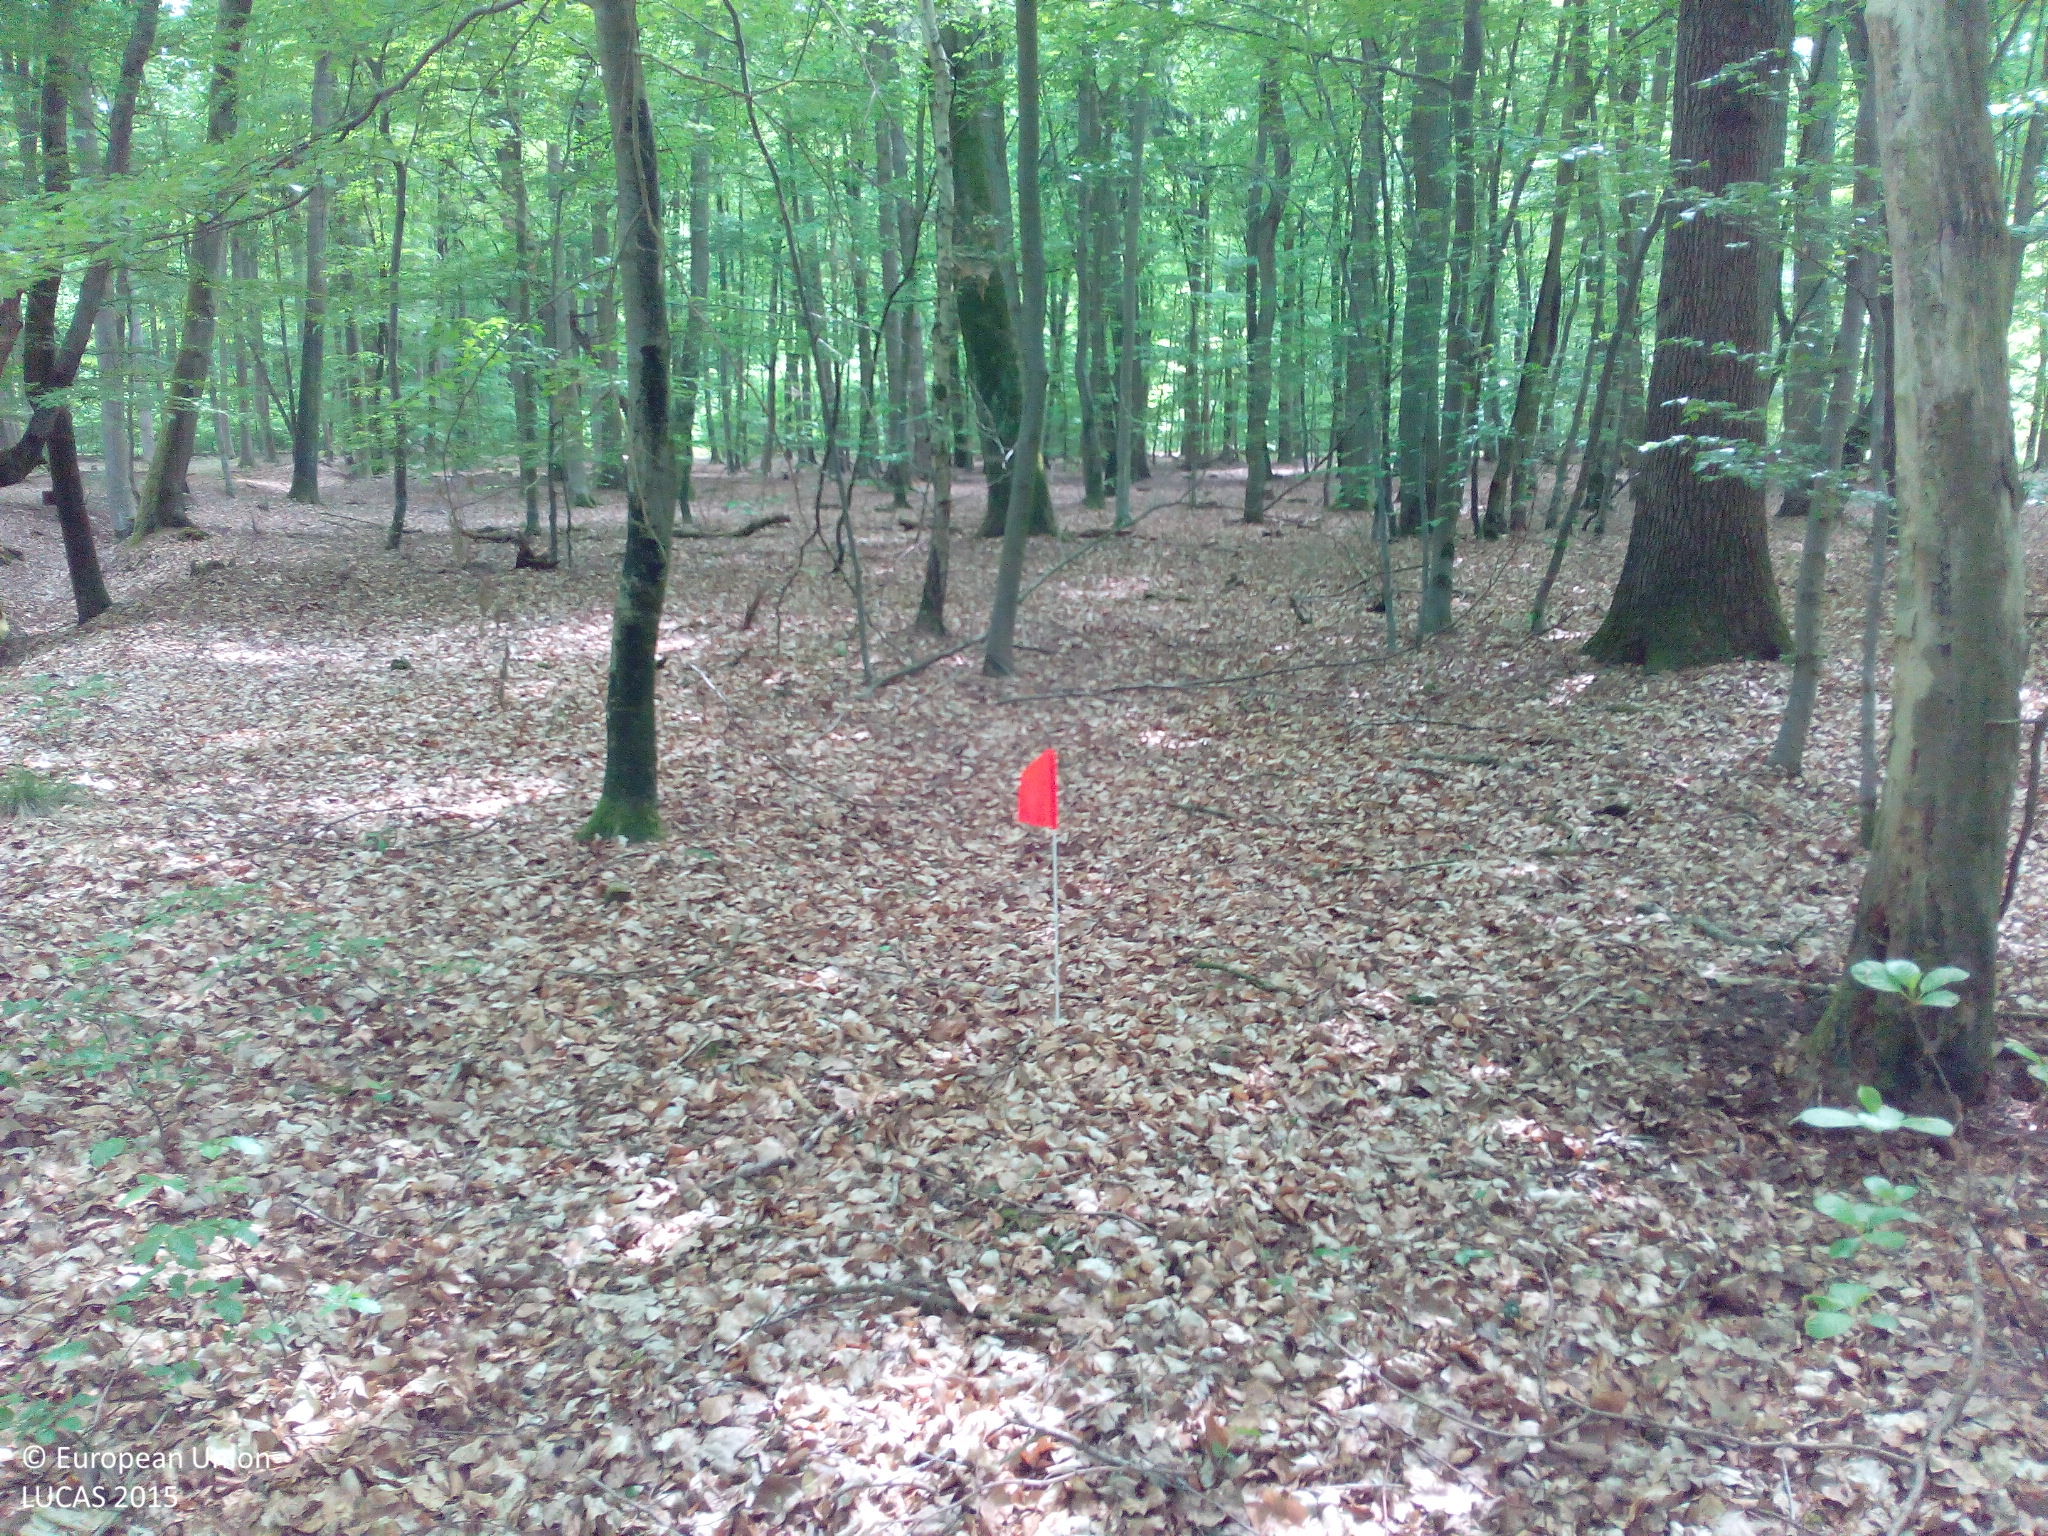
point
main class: Woodland
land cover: Broadleaved woodland
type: beech forest
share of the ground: 25 - 50 %
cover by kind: broadleaved forest trees 80 %, unconsolidated bare surface 20 %
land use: Forestry
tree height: > 5 m
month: May
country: DE
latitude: 53.4987
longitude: 11.6425
